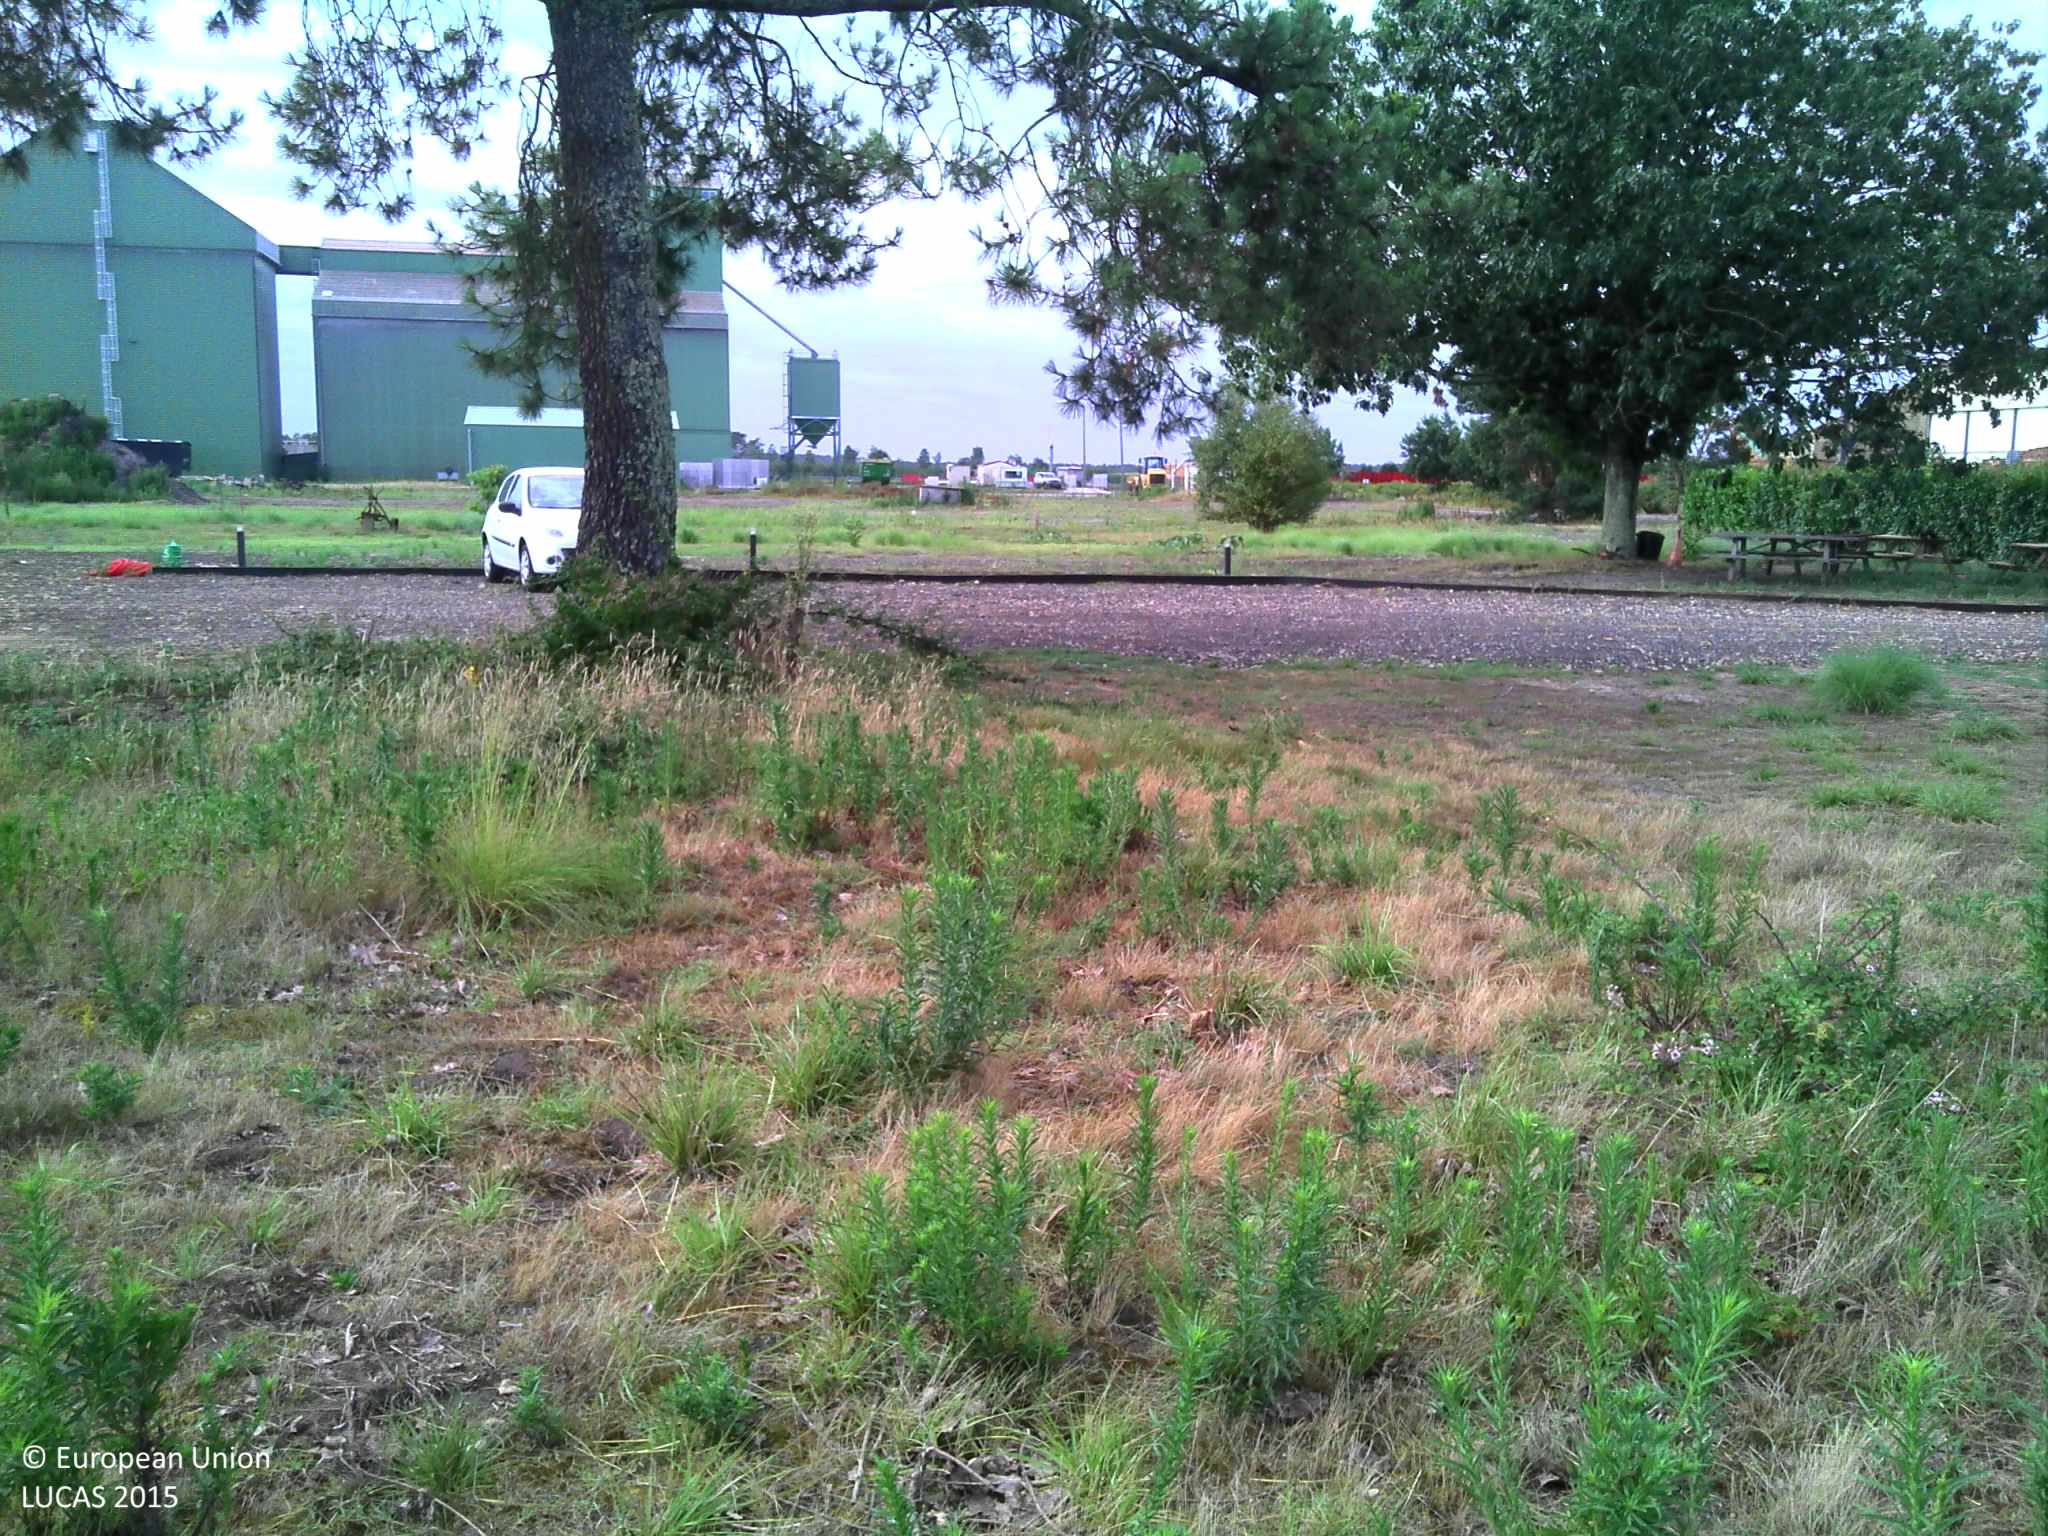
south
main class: Grassland
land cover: Grassland with sparse tree/shrub cover
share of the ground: > 75 %
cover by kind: herbaceous plants 95 %, coniferous forest trees 5 %
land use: Residential
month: July
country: FR
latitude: 44.3418
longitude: -0.8680
